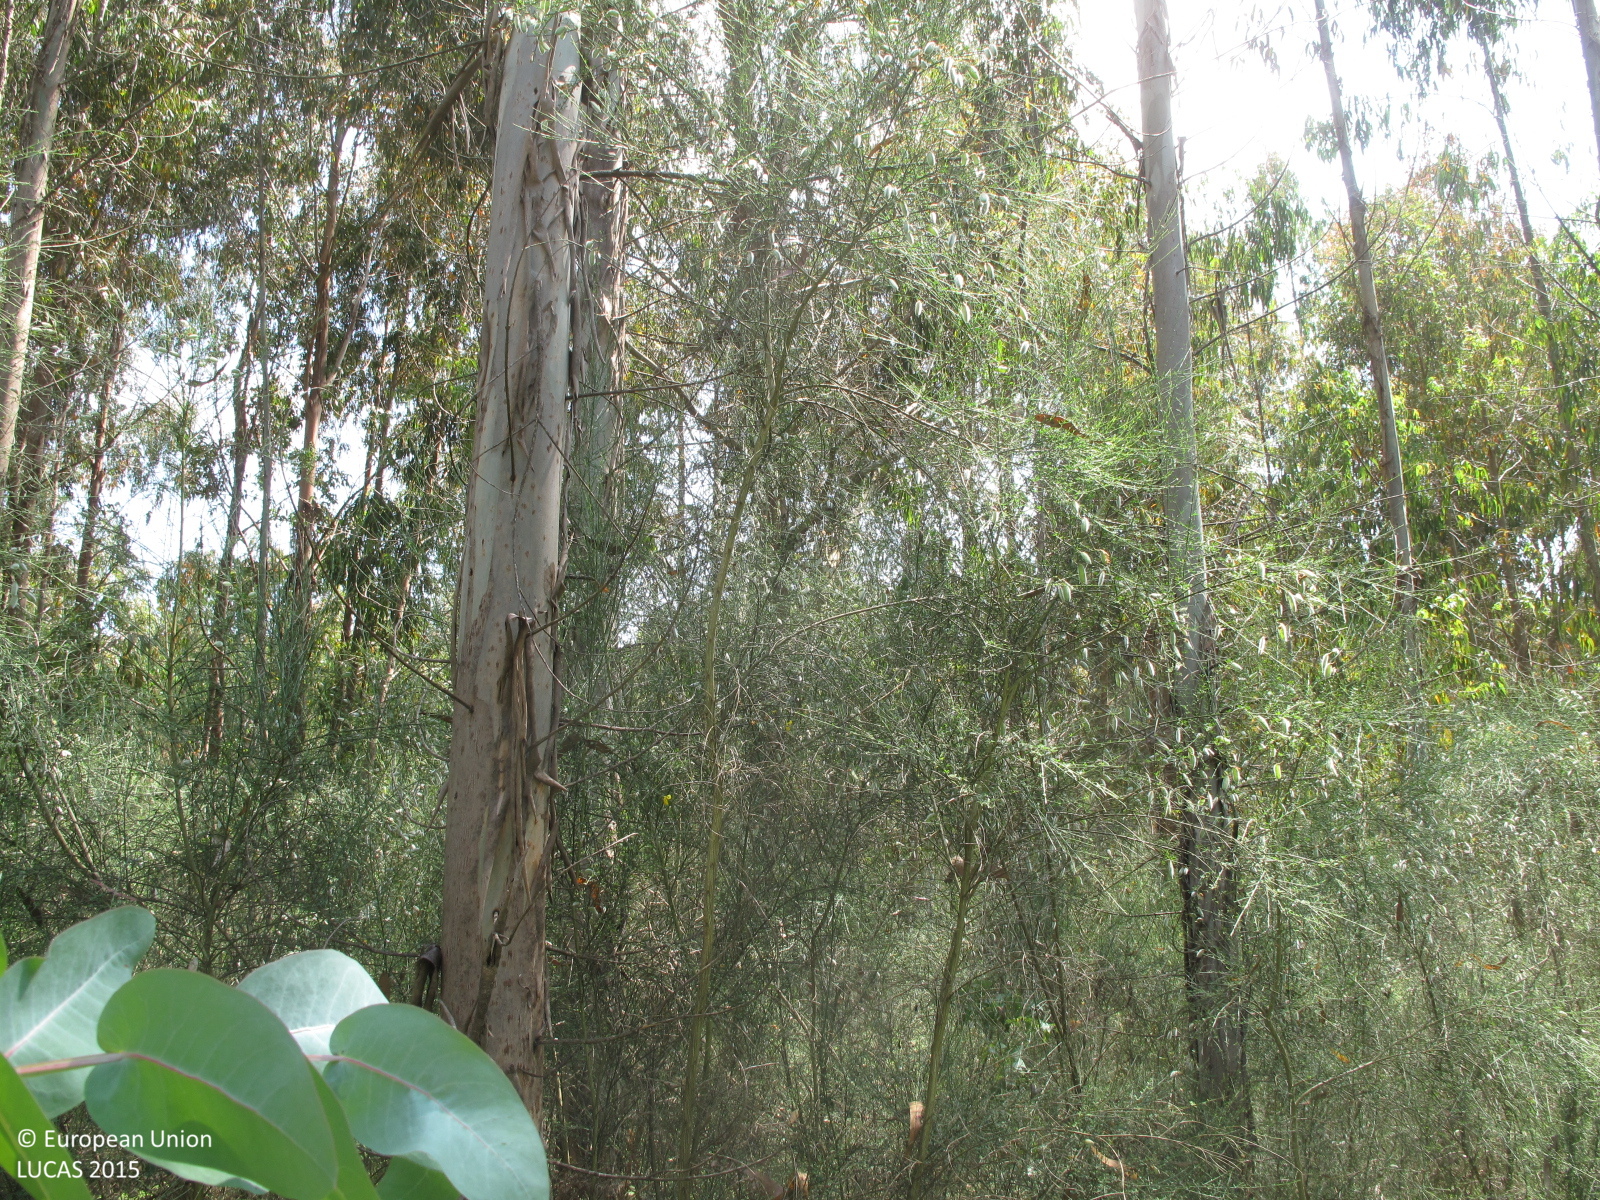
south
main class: Woodland
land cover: Broadleaved woodland
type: exotic forest
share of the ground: 10 - 25 %
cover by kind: shrubs 40 %, herbaceous plants 40 %, broadleaved forest trees 20 %
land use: Forestry
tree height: < 5 m
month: June
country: ES
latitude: 43.0289
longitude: -8.0462
